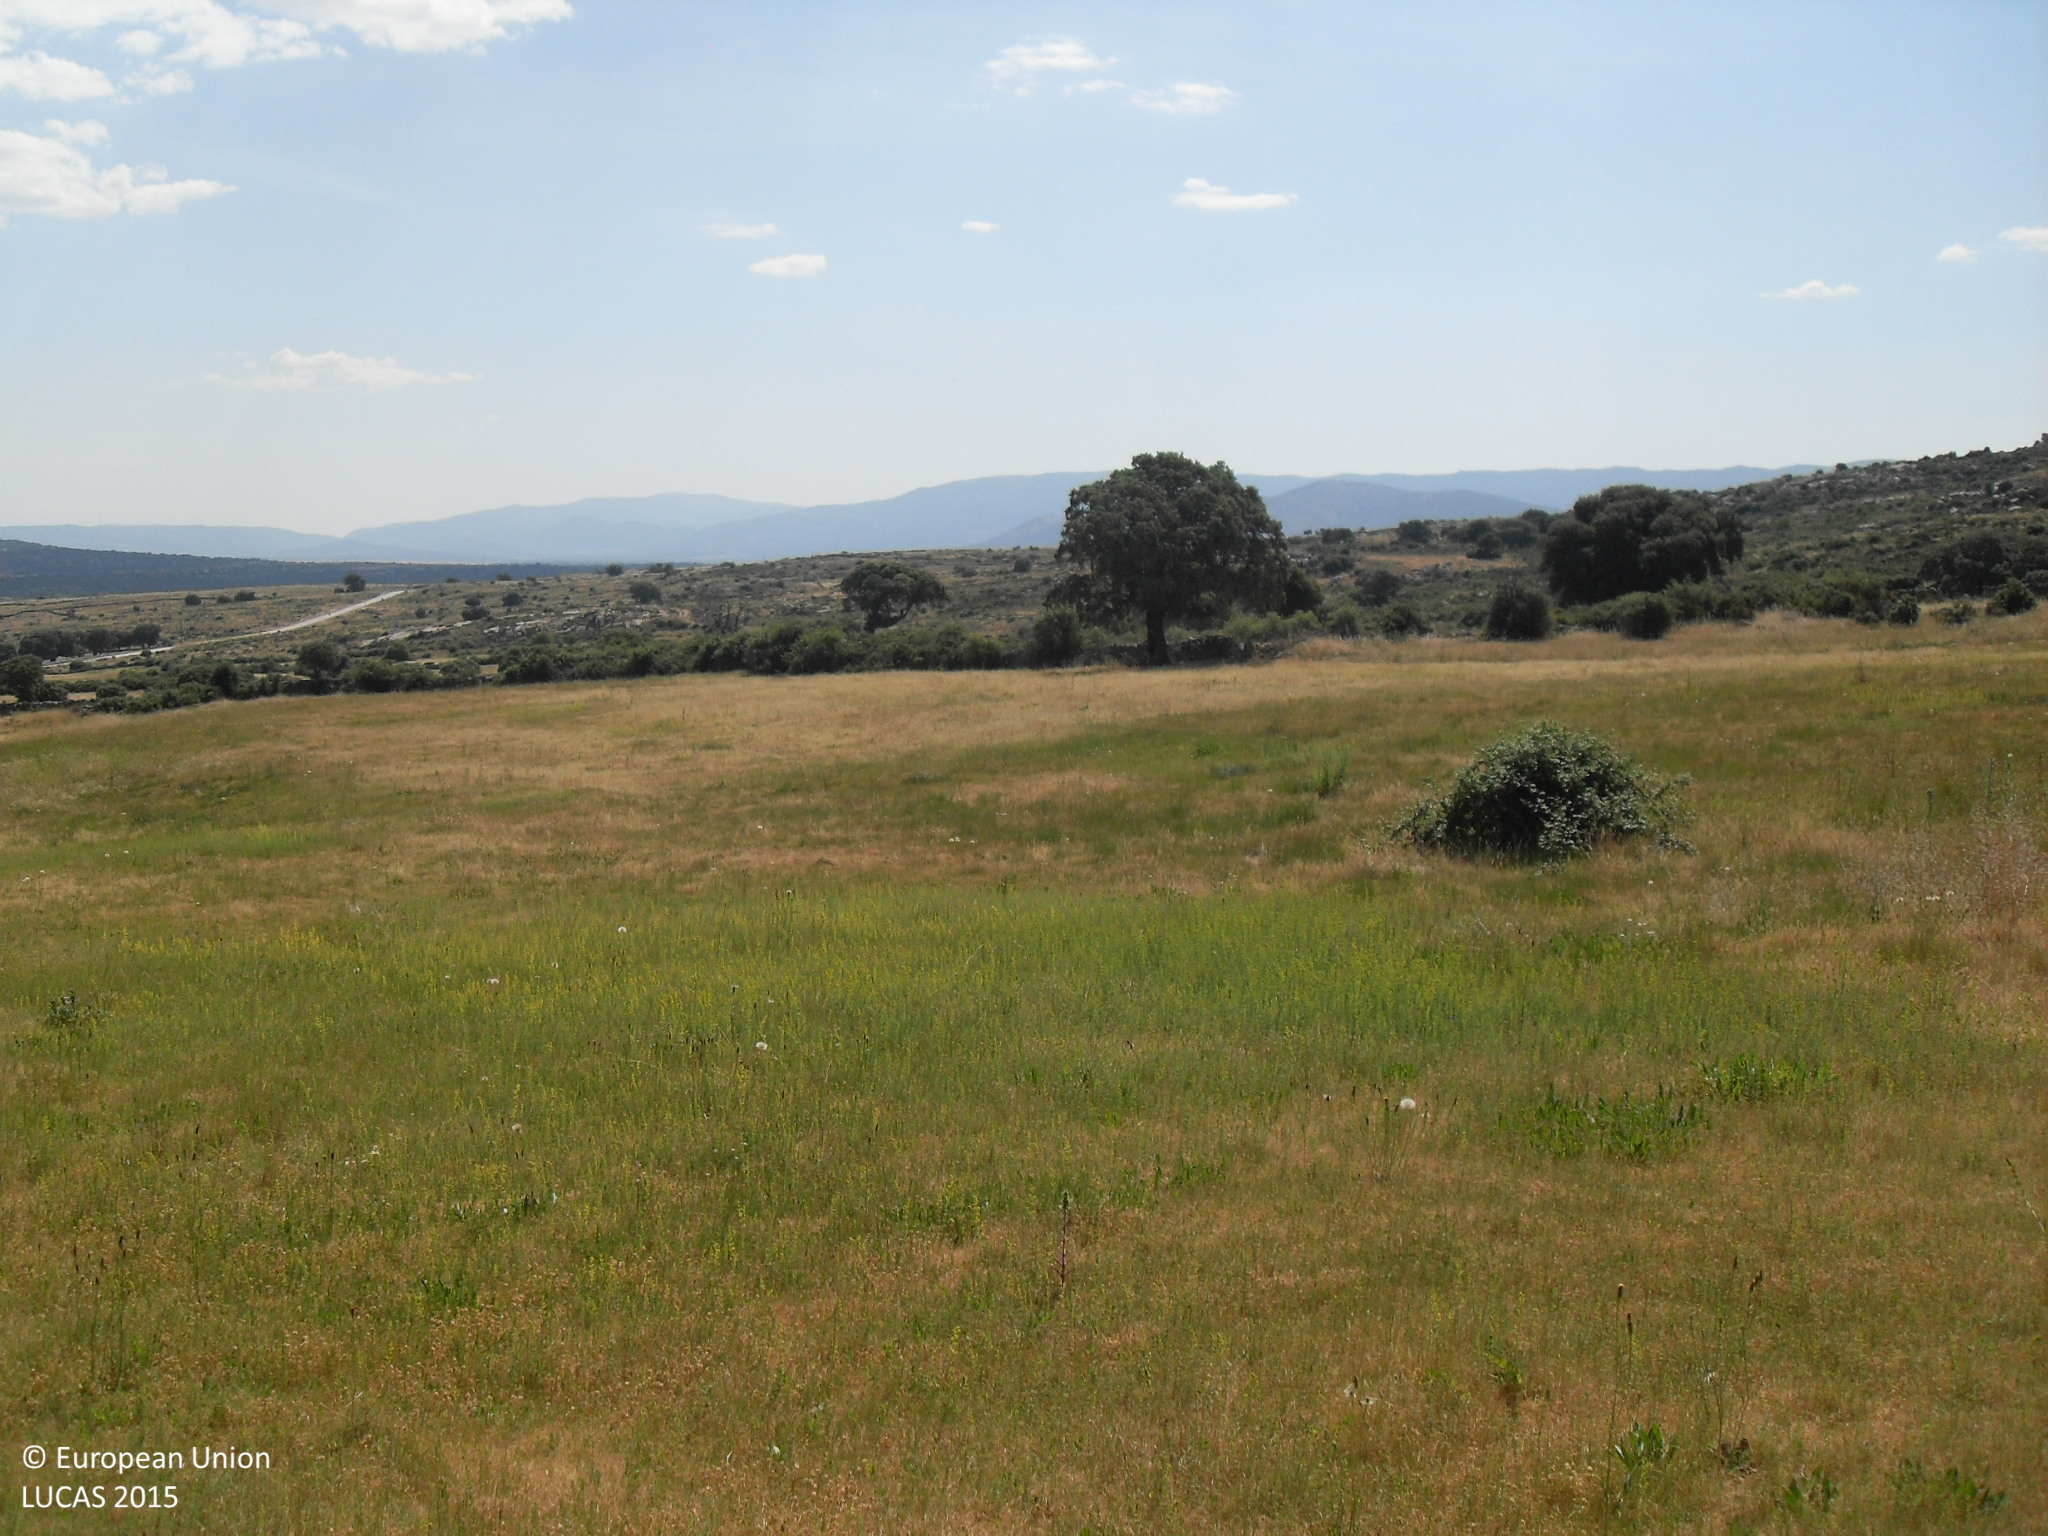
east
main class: Grassland
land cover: Grassland with sparse tree/shrub cover
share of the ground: > 75 %
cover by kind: herbaceous plants 95 %, broadleaved forest trees 5 %
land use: Agriculture (excluding fallow land and kitchen gardens)
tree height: < 5 m
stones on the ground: < 10 %
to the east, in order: Grassland with sparse tree/shrub cover; Grassland without tree/shrub cover; Dry stone walls; Grassland with sparse tree/shrub cover; Dry stone walls; Grassland with sparse tree/shrub cover
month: June
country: ES
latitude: 40.4704
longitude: -5.5542
